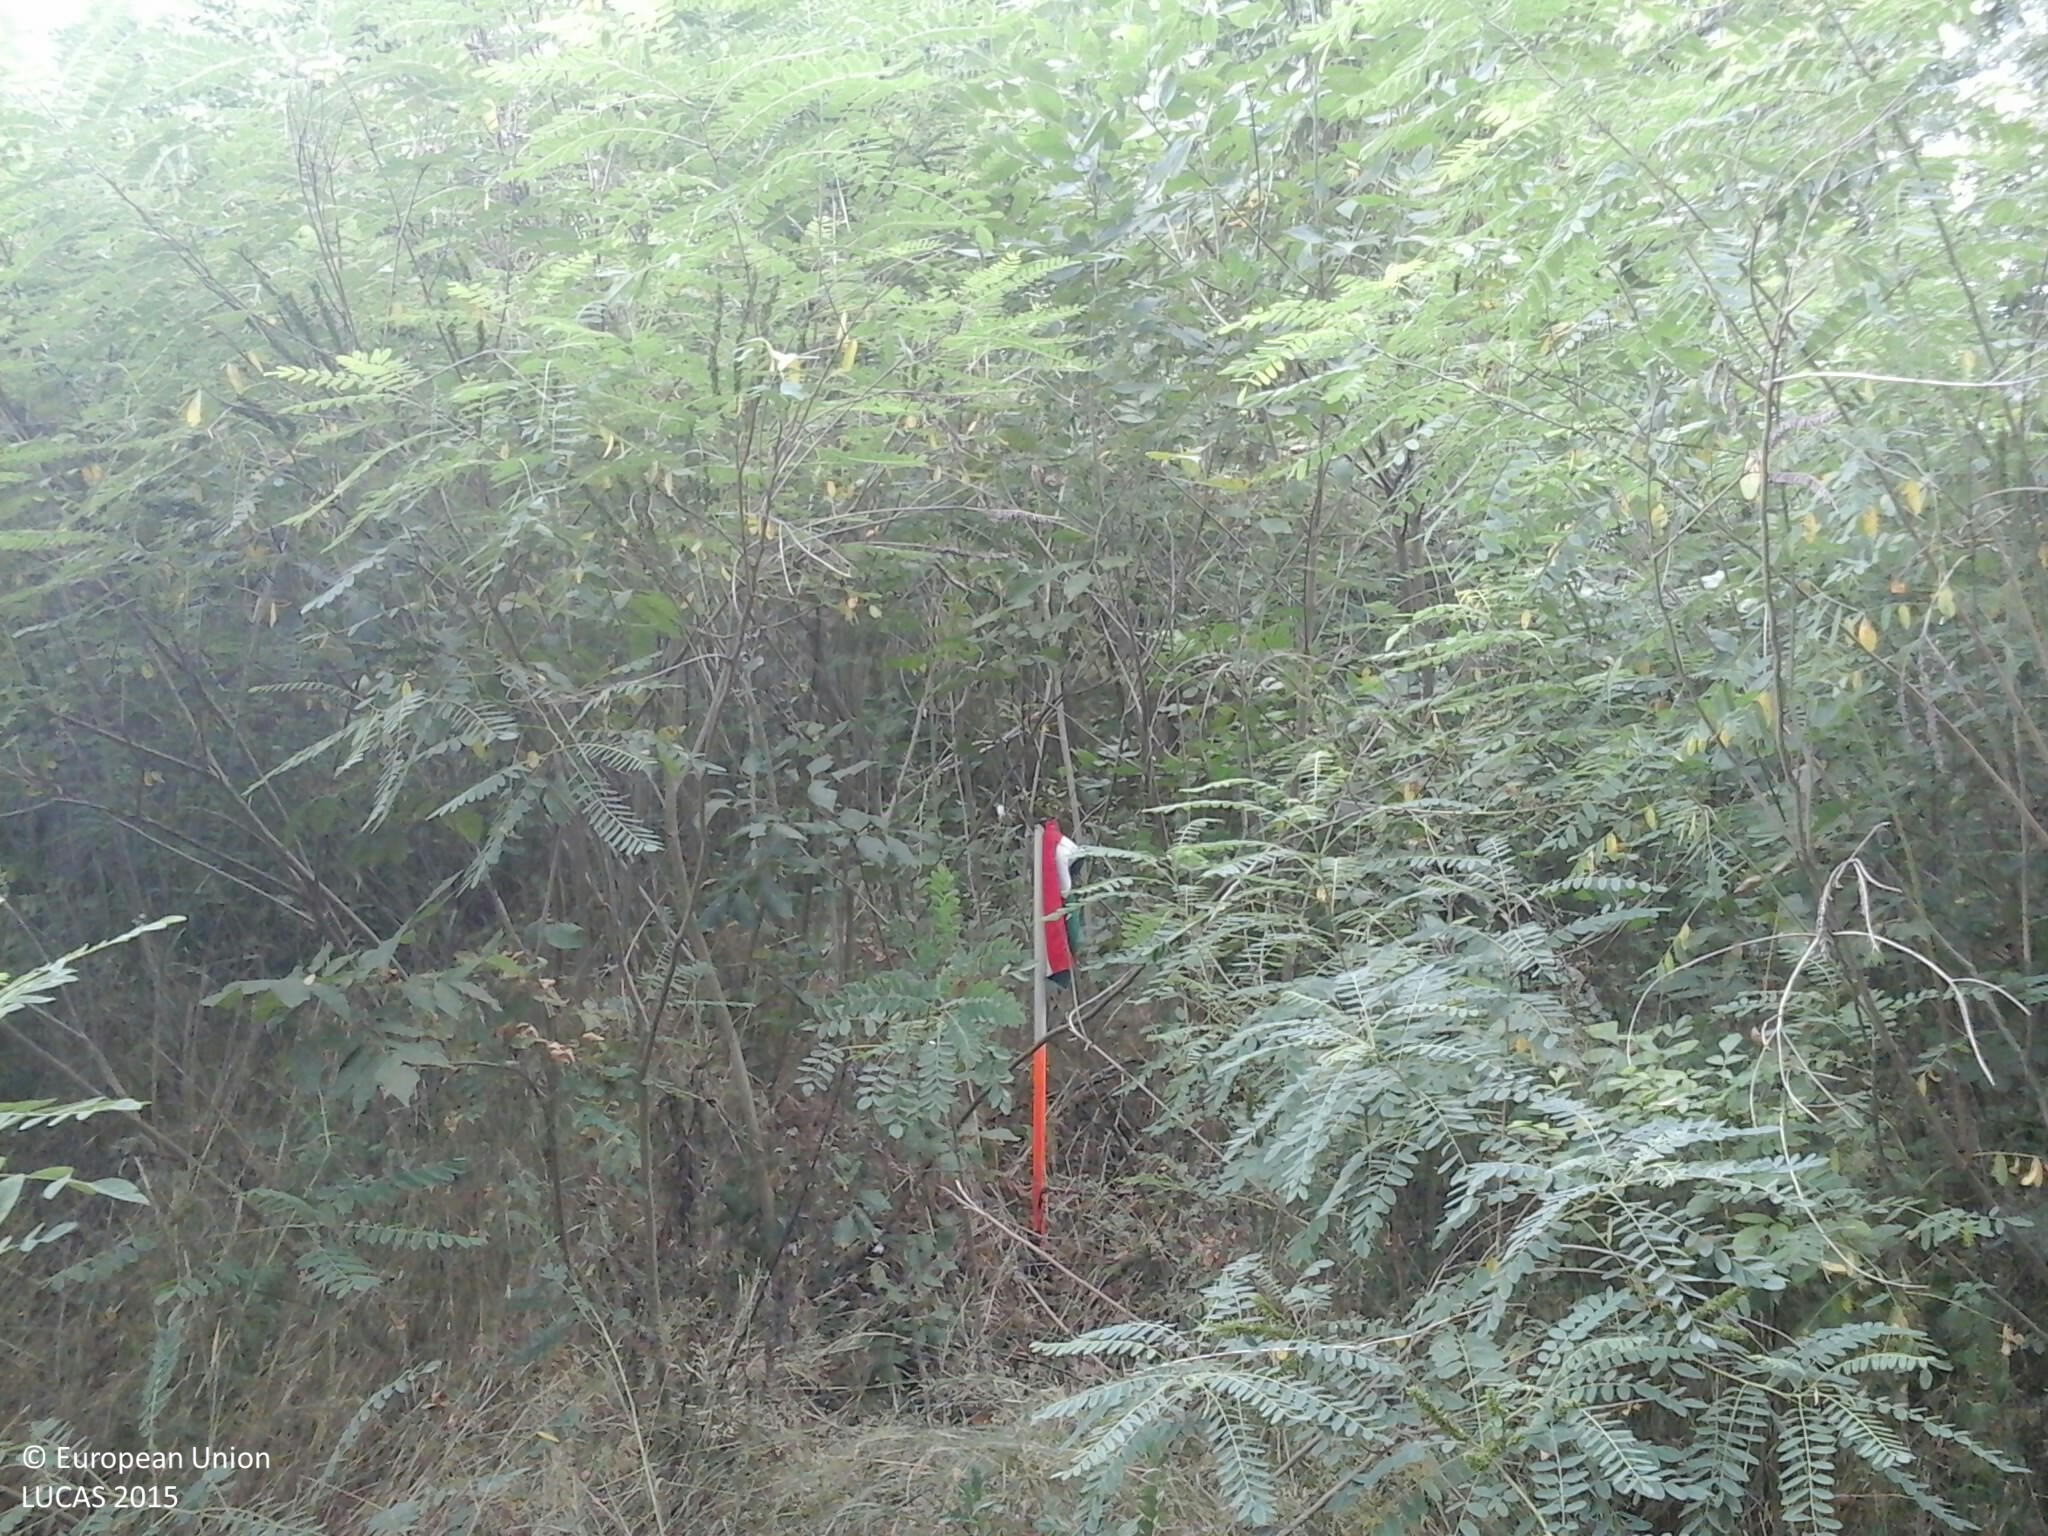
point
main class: Woodland
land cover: Broadleaved woodland
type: floodplain forest
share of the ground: > 75 %
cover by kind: broadleaved forest trees 90 %, shrubs 5 %, herbaceous plants 5 %
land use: Forestry
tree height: < 5 m
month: July
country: HU
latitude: 46.9577
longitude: 20.1302
